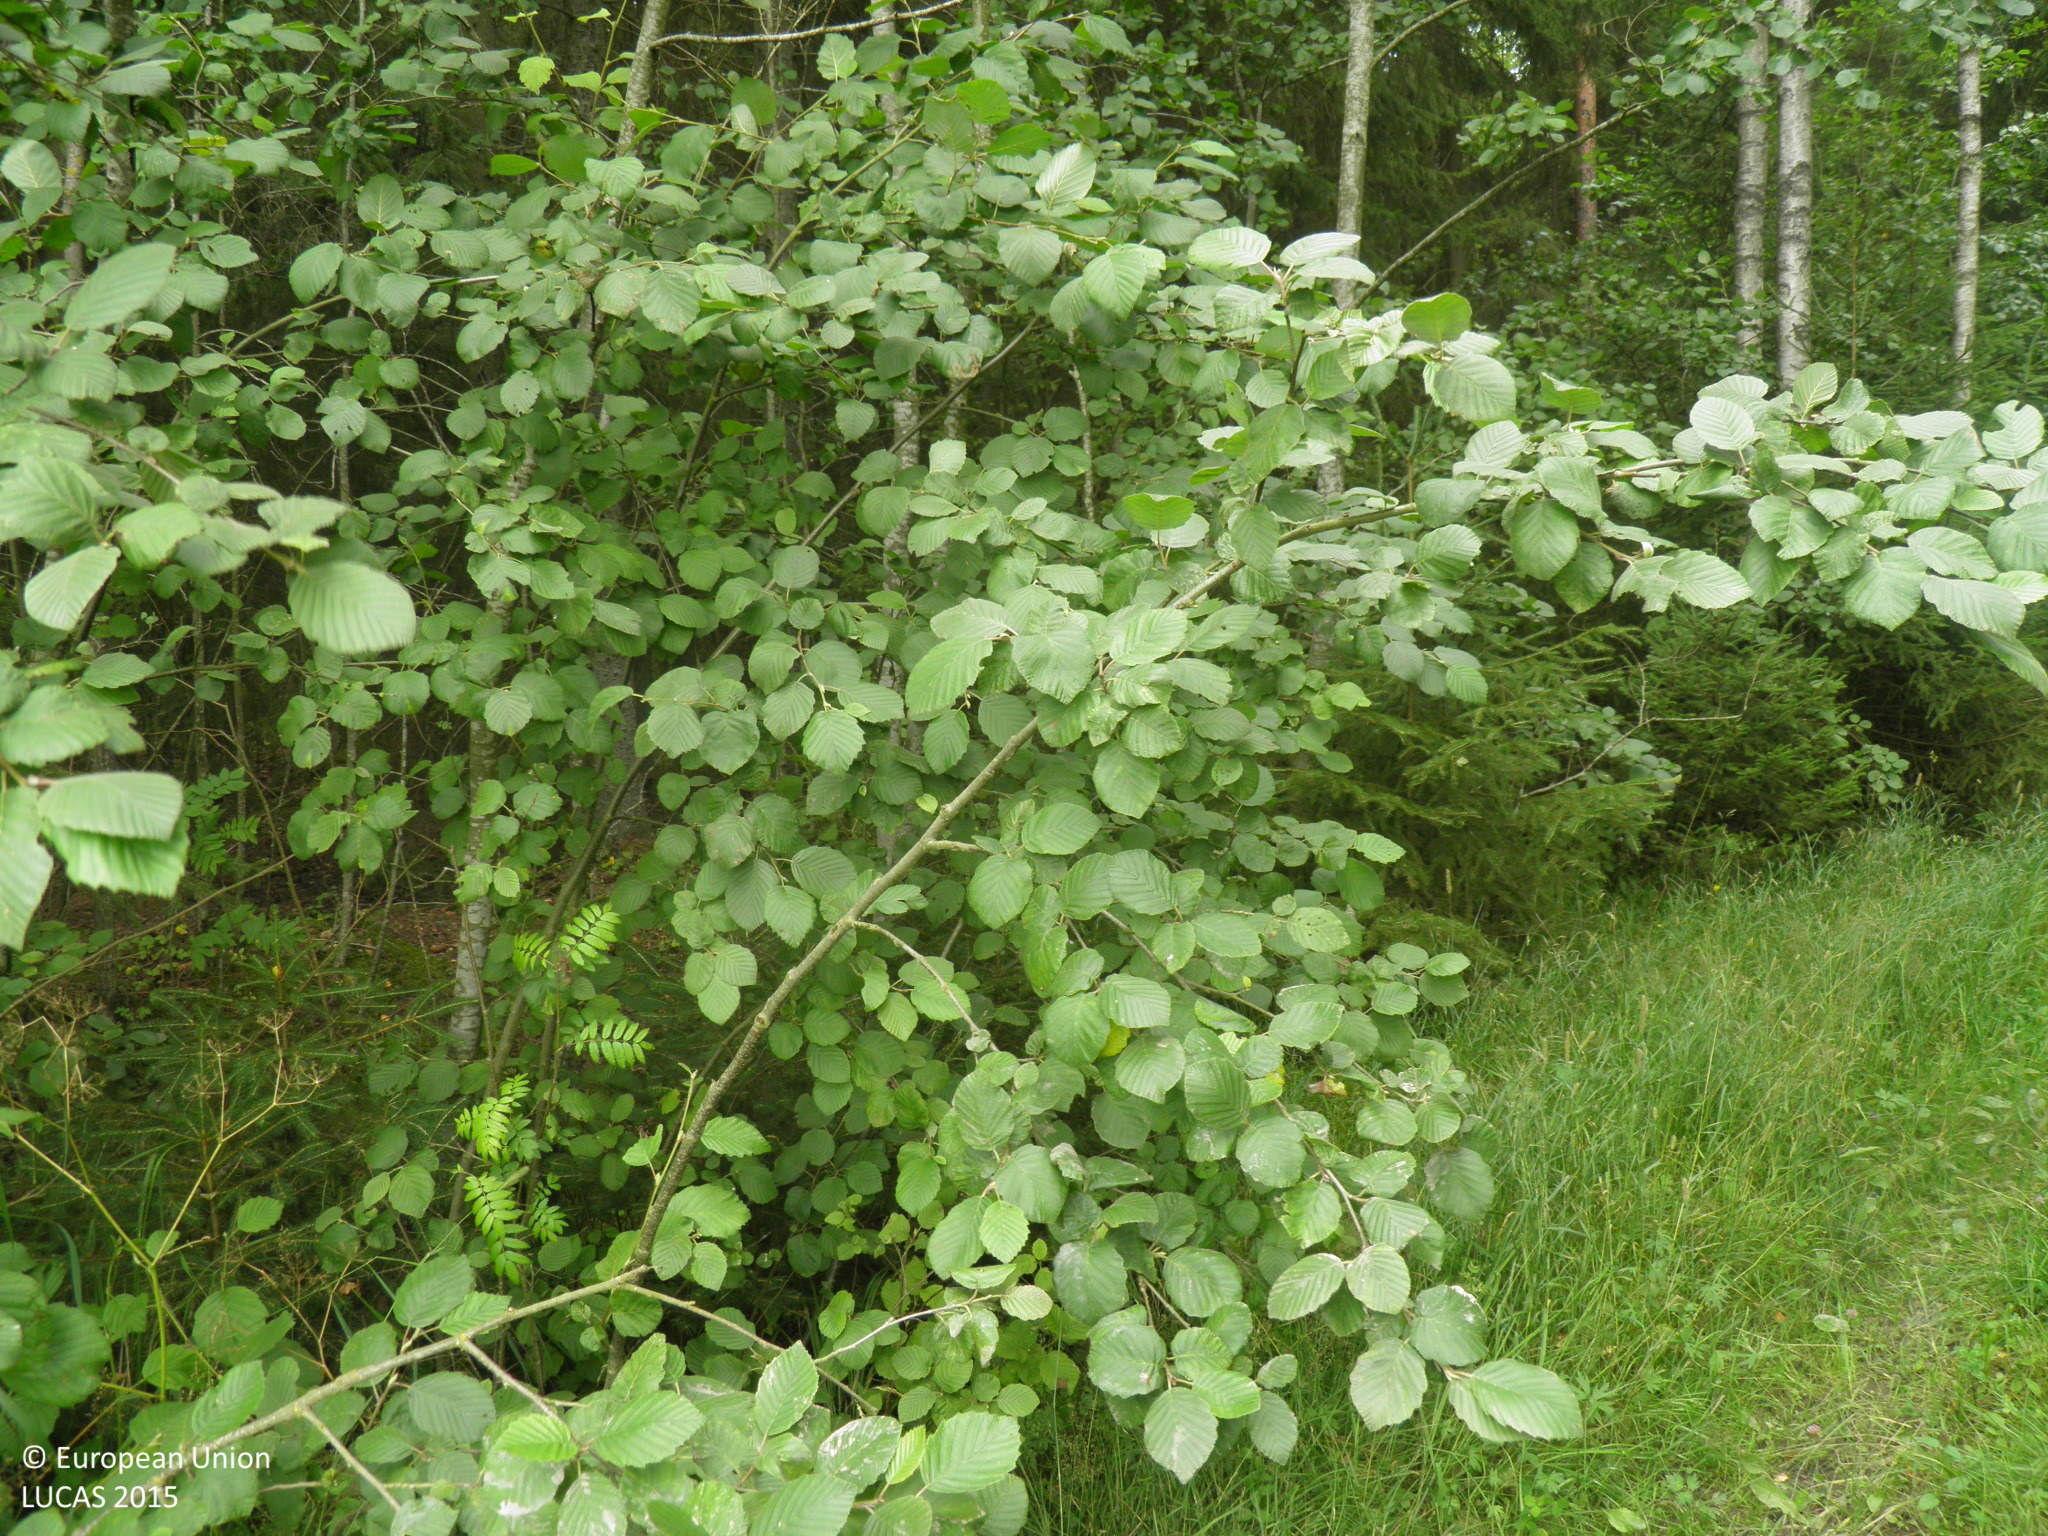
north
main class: Woodland
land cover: Spruce dominated coniferous woodland
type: boreal forest
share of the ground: 50 - 75 %
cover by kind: coniferous forest trees 60 %, broadleaved forest trees 10 %, shrubs 10 %, herbaceous plants 10 %, lichens and mosses 10 %
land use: Forestry
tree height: > 5 m
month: August
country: FI
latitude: 61.0748
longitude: 22.8041
